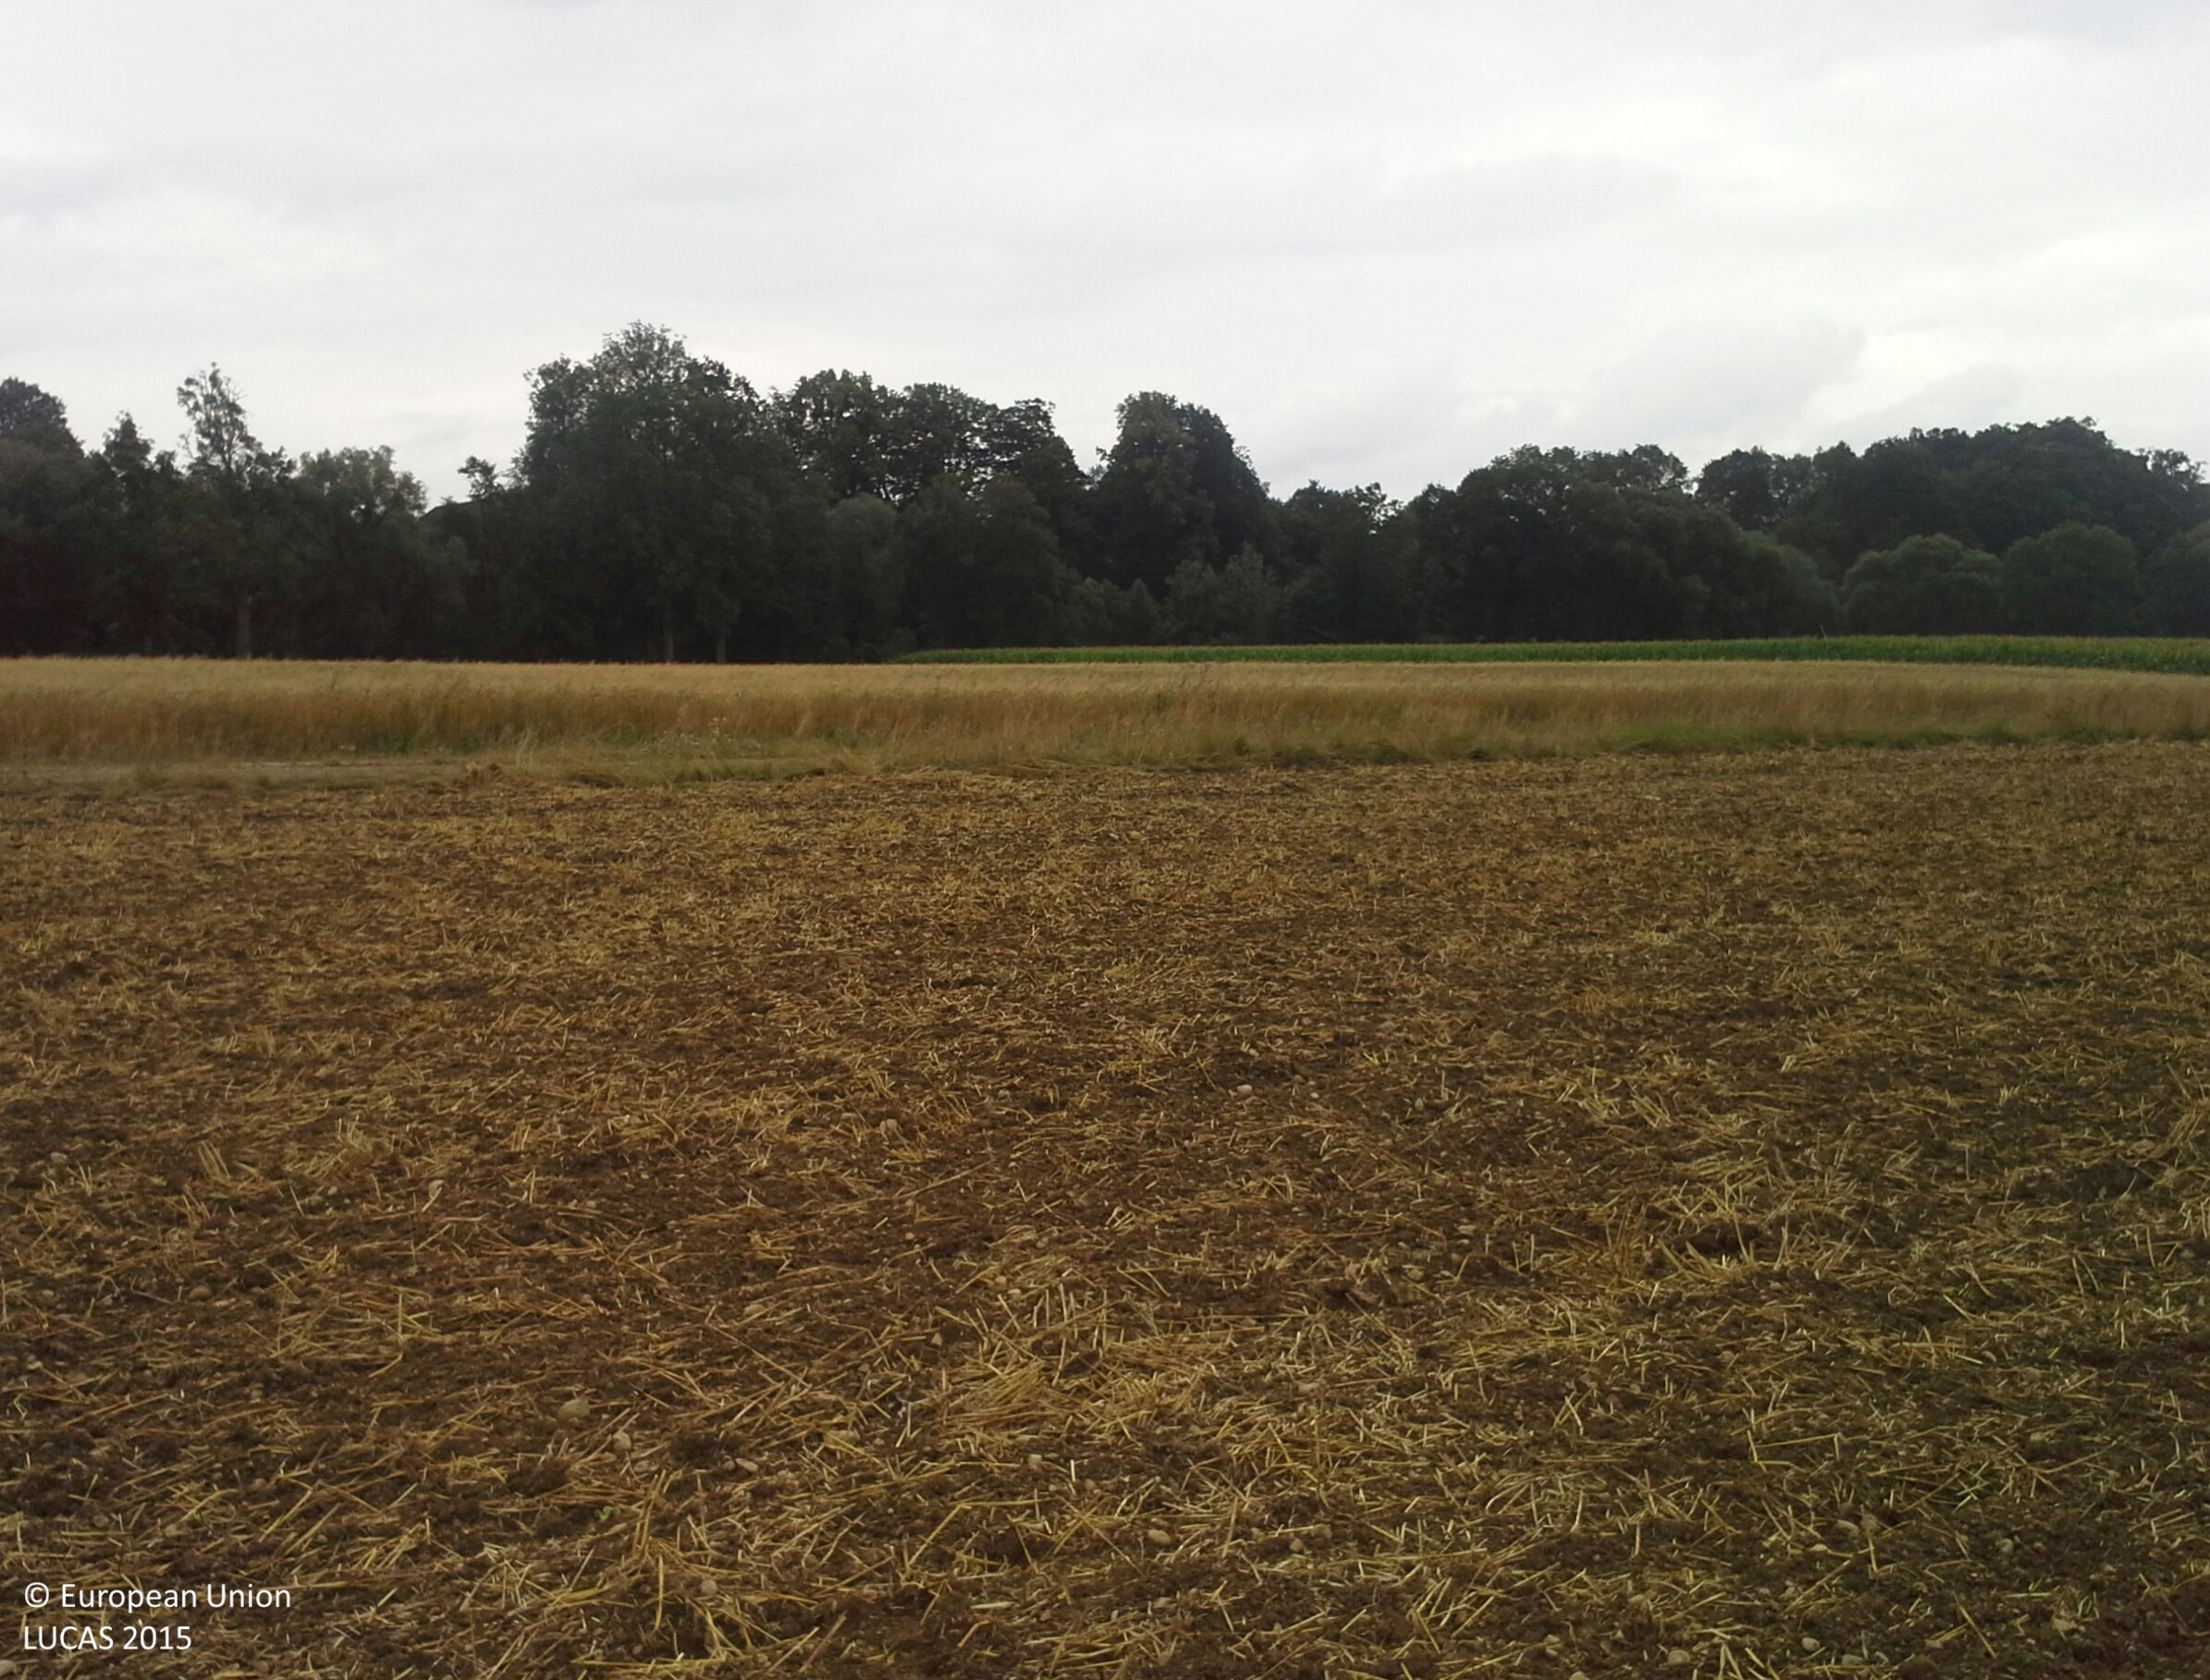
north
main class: Cropland
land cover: Barley
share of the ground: 10 - 25 %
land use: Agriculture (excluding fallow land and kitchen gardens)
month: July
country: AT
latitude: 48.0630
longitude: 14.8449
